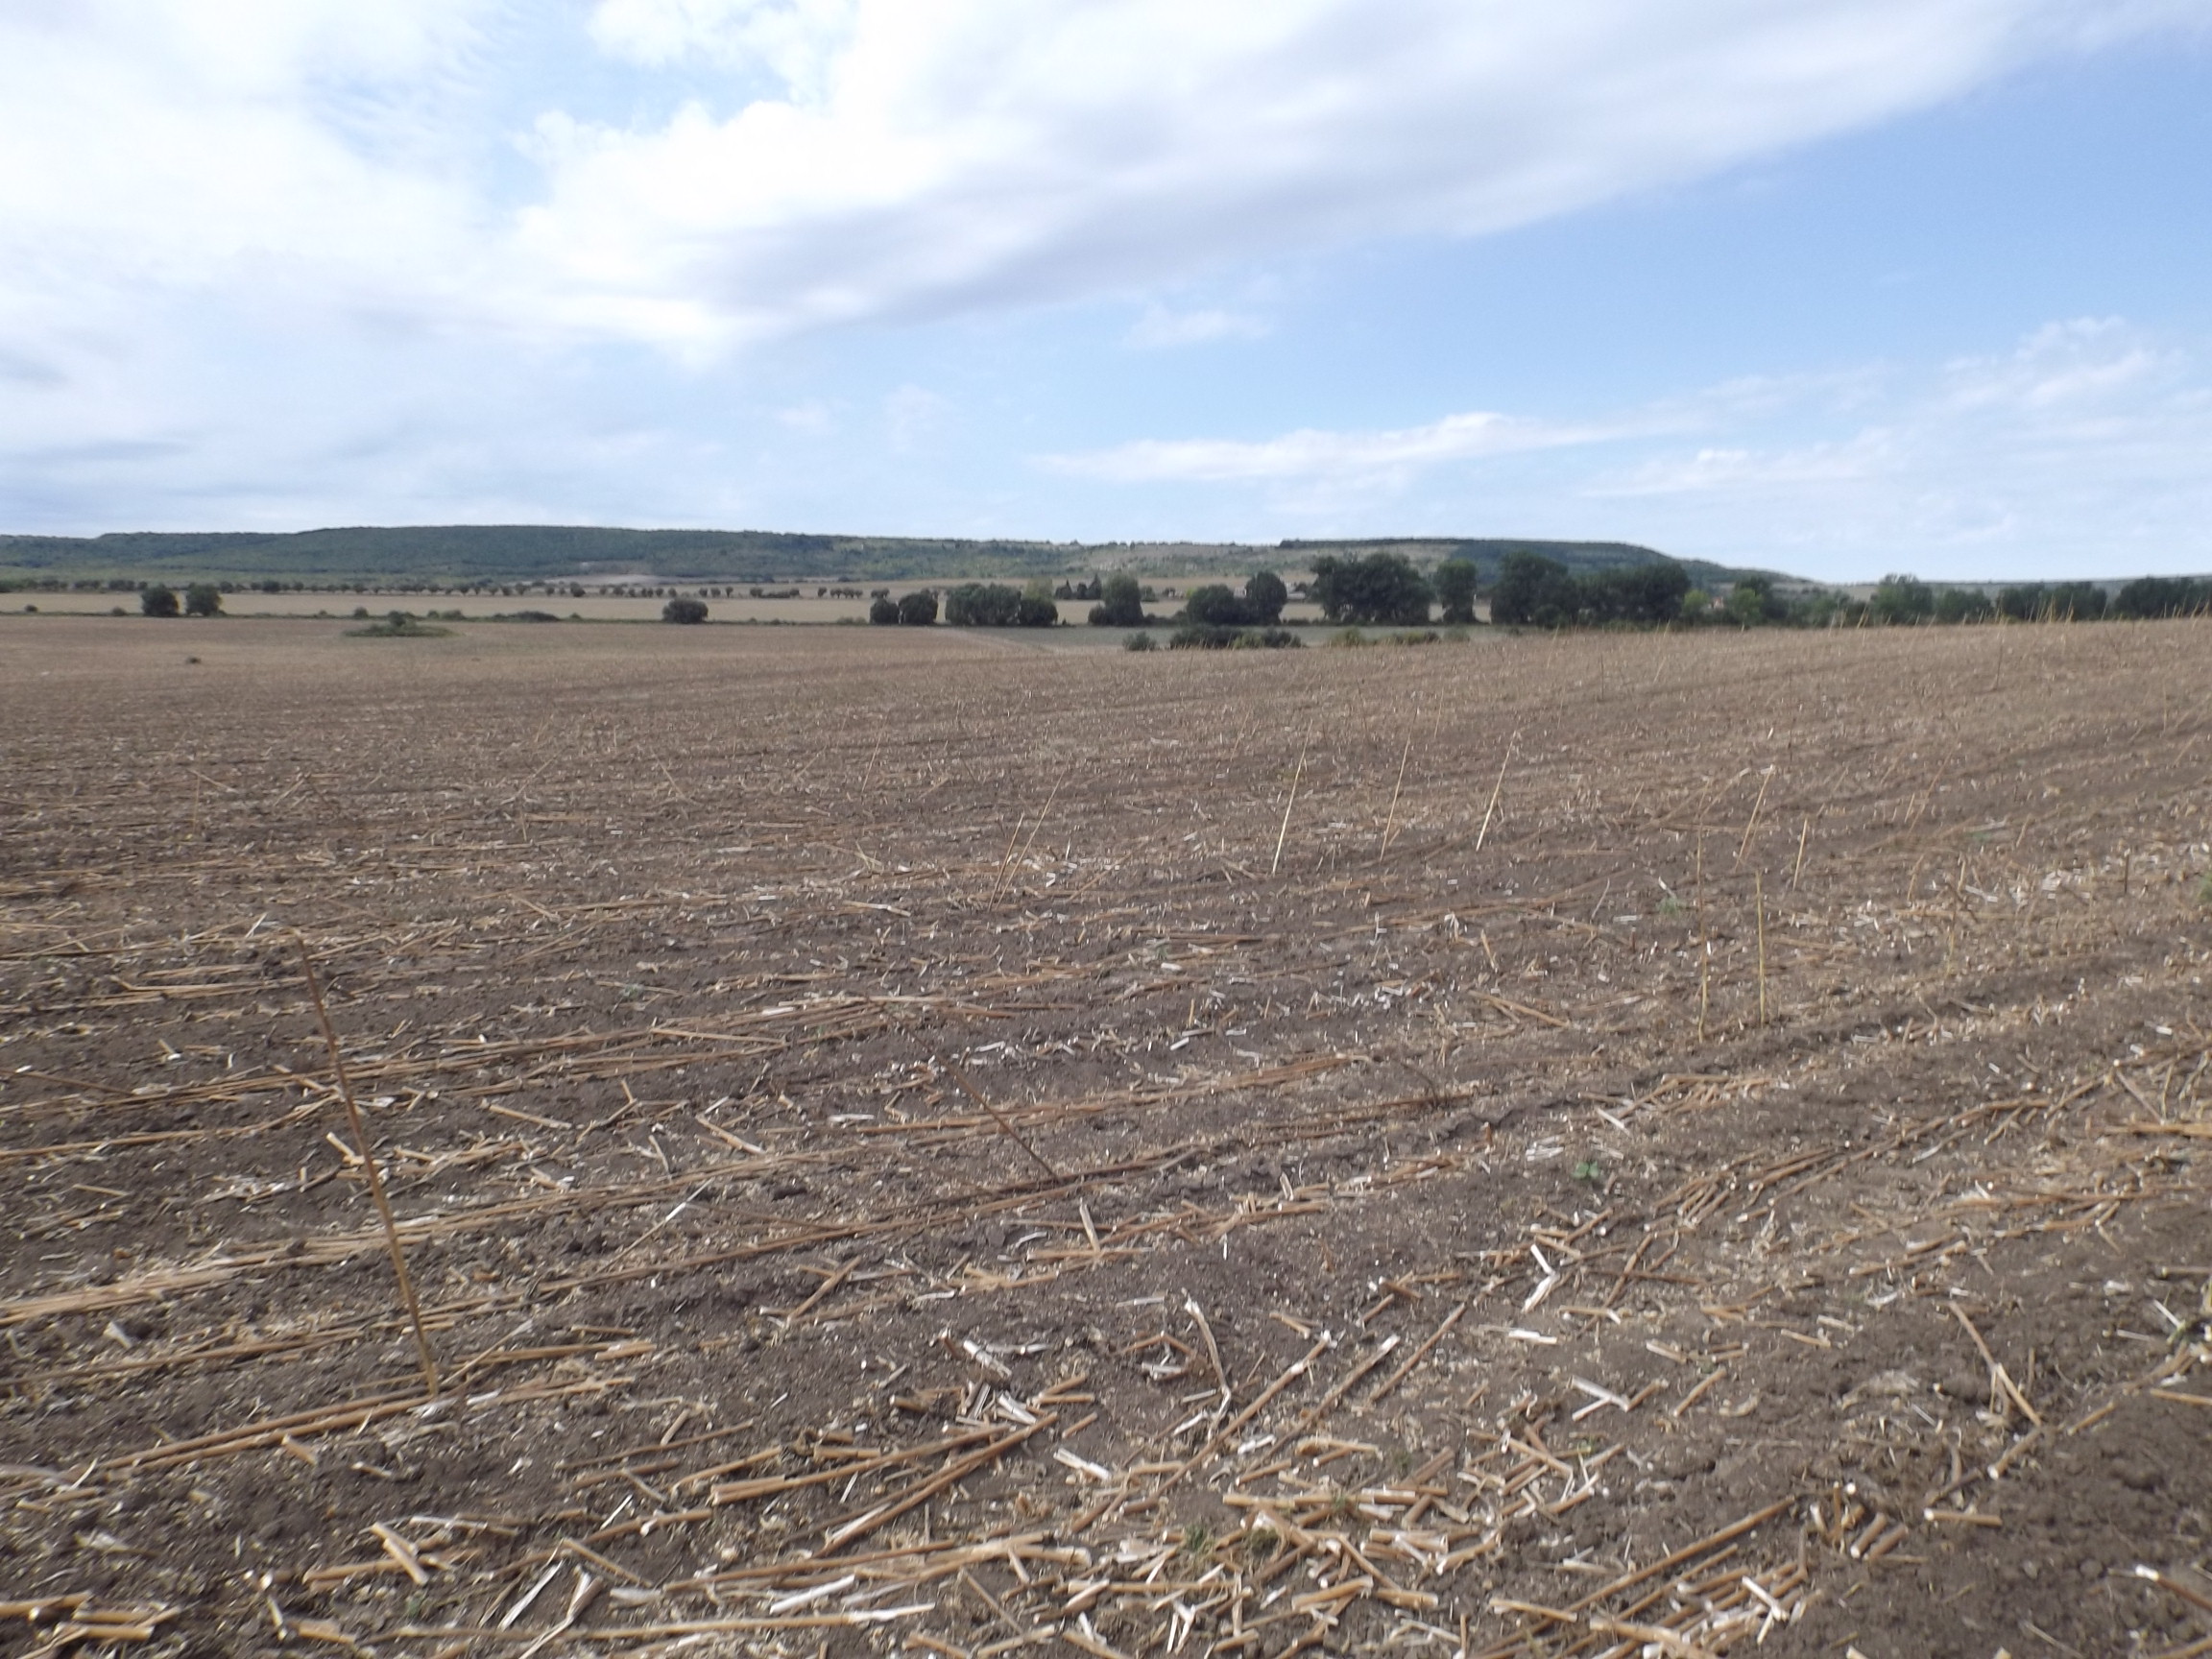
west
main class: Cropland
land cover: Sunflower
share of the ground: < 10 %
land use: Agriculture (excluding fallow land and kitchen gardens)
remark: Harvested field
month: September
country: BG
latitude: 43.3740
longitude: 27.3419
